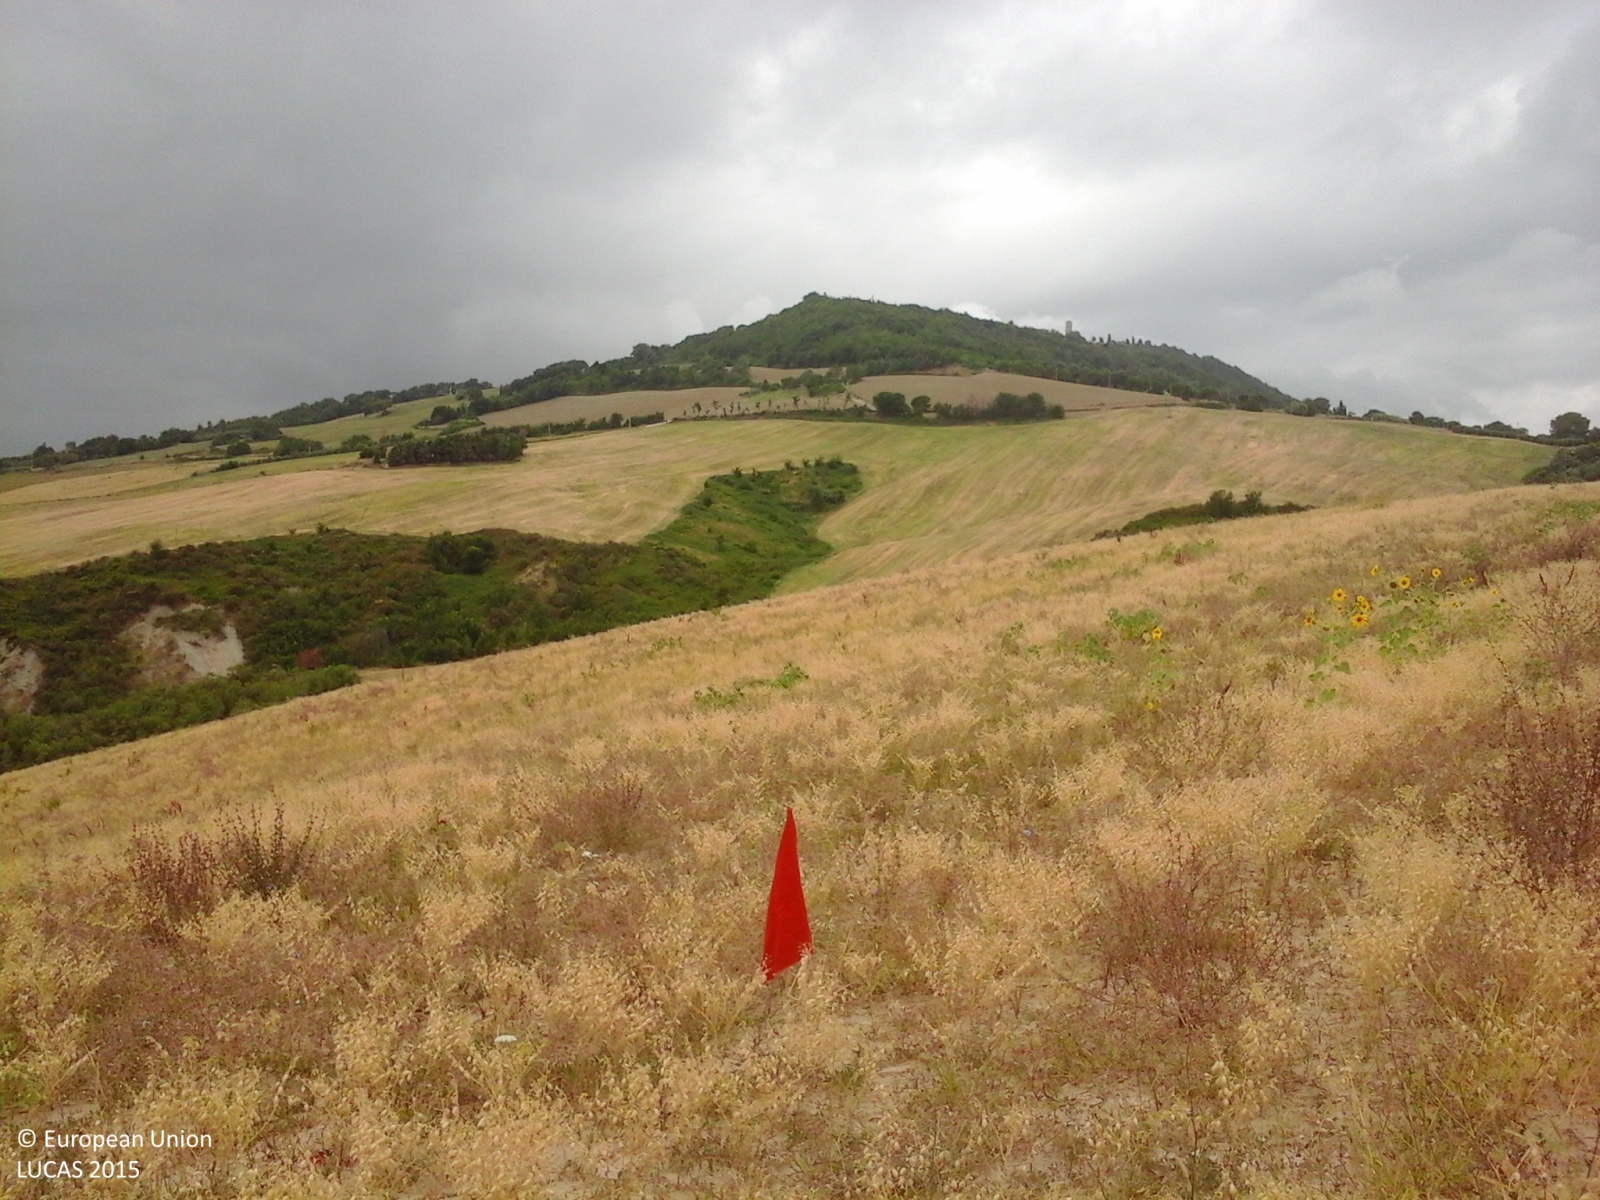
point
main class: Cropland
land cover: Dry pulses
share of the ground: > 75 %
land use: Agriculture (excluding fallow land and kitchen gardens)
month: July
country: IT
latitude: 43.2883
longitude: 13.2575
